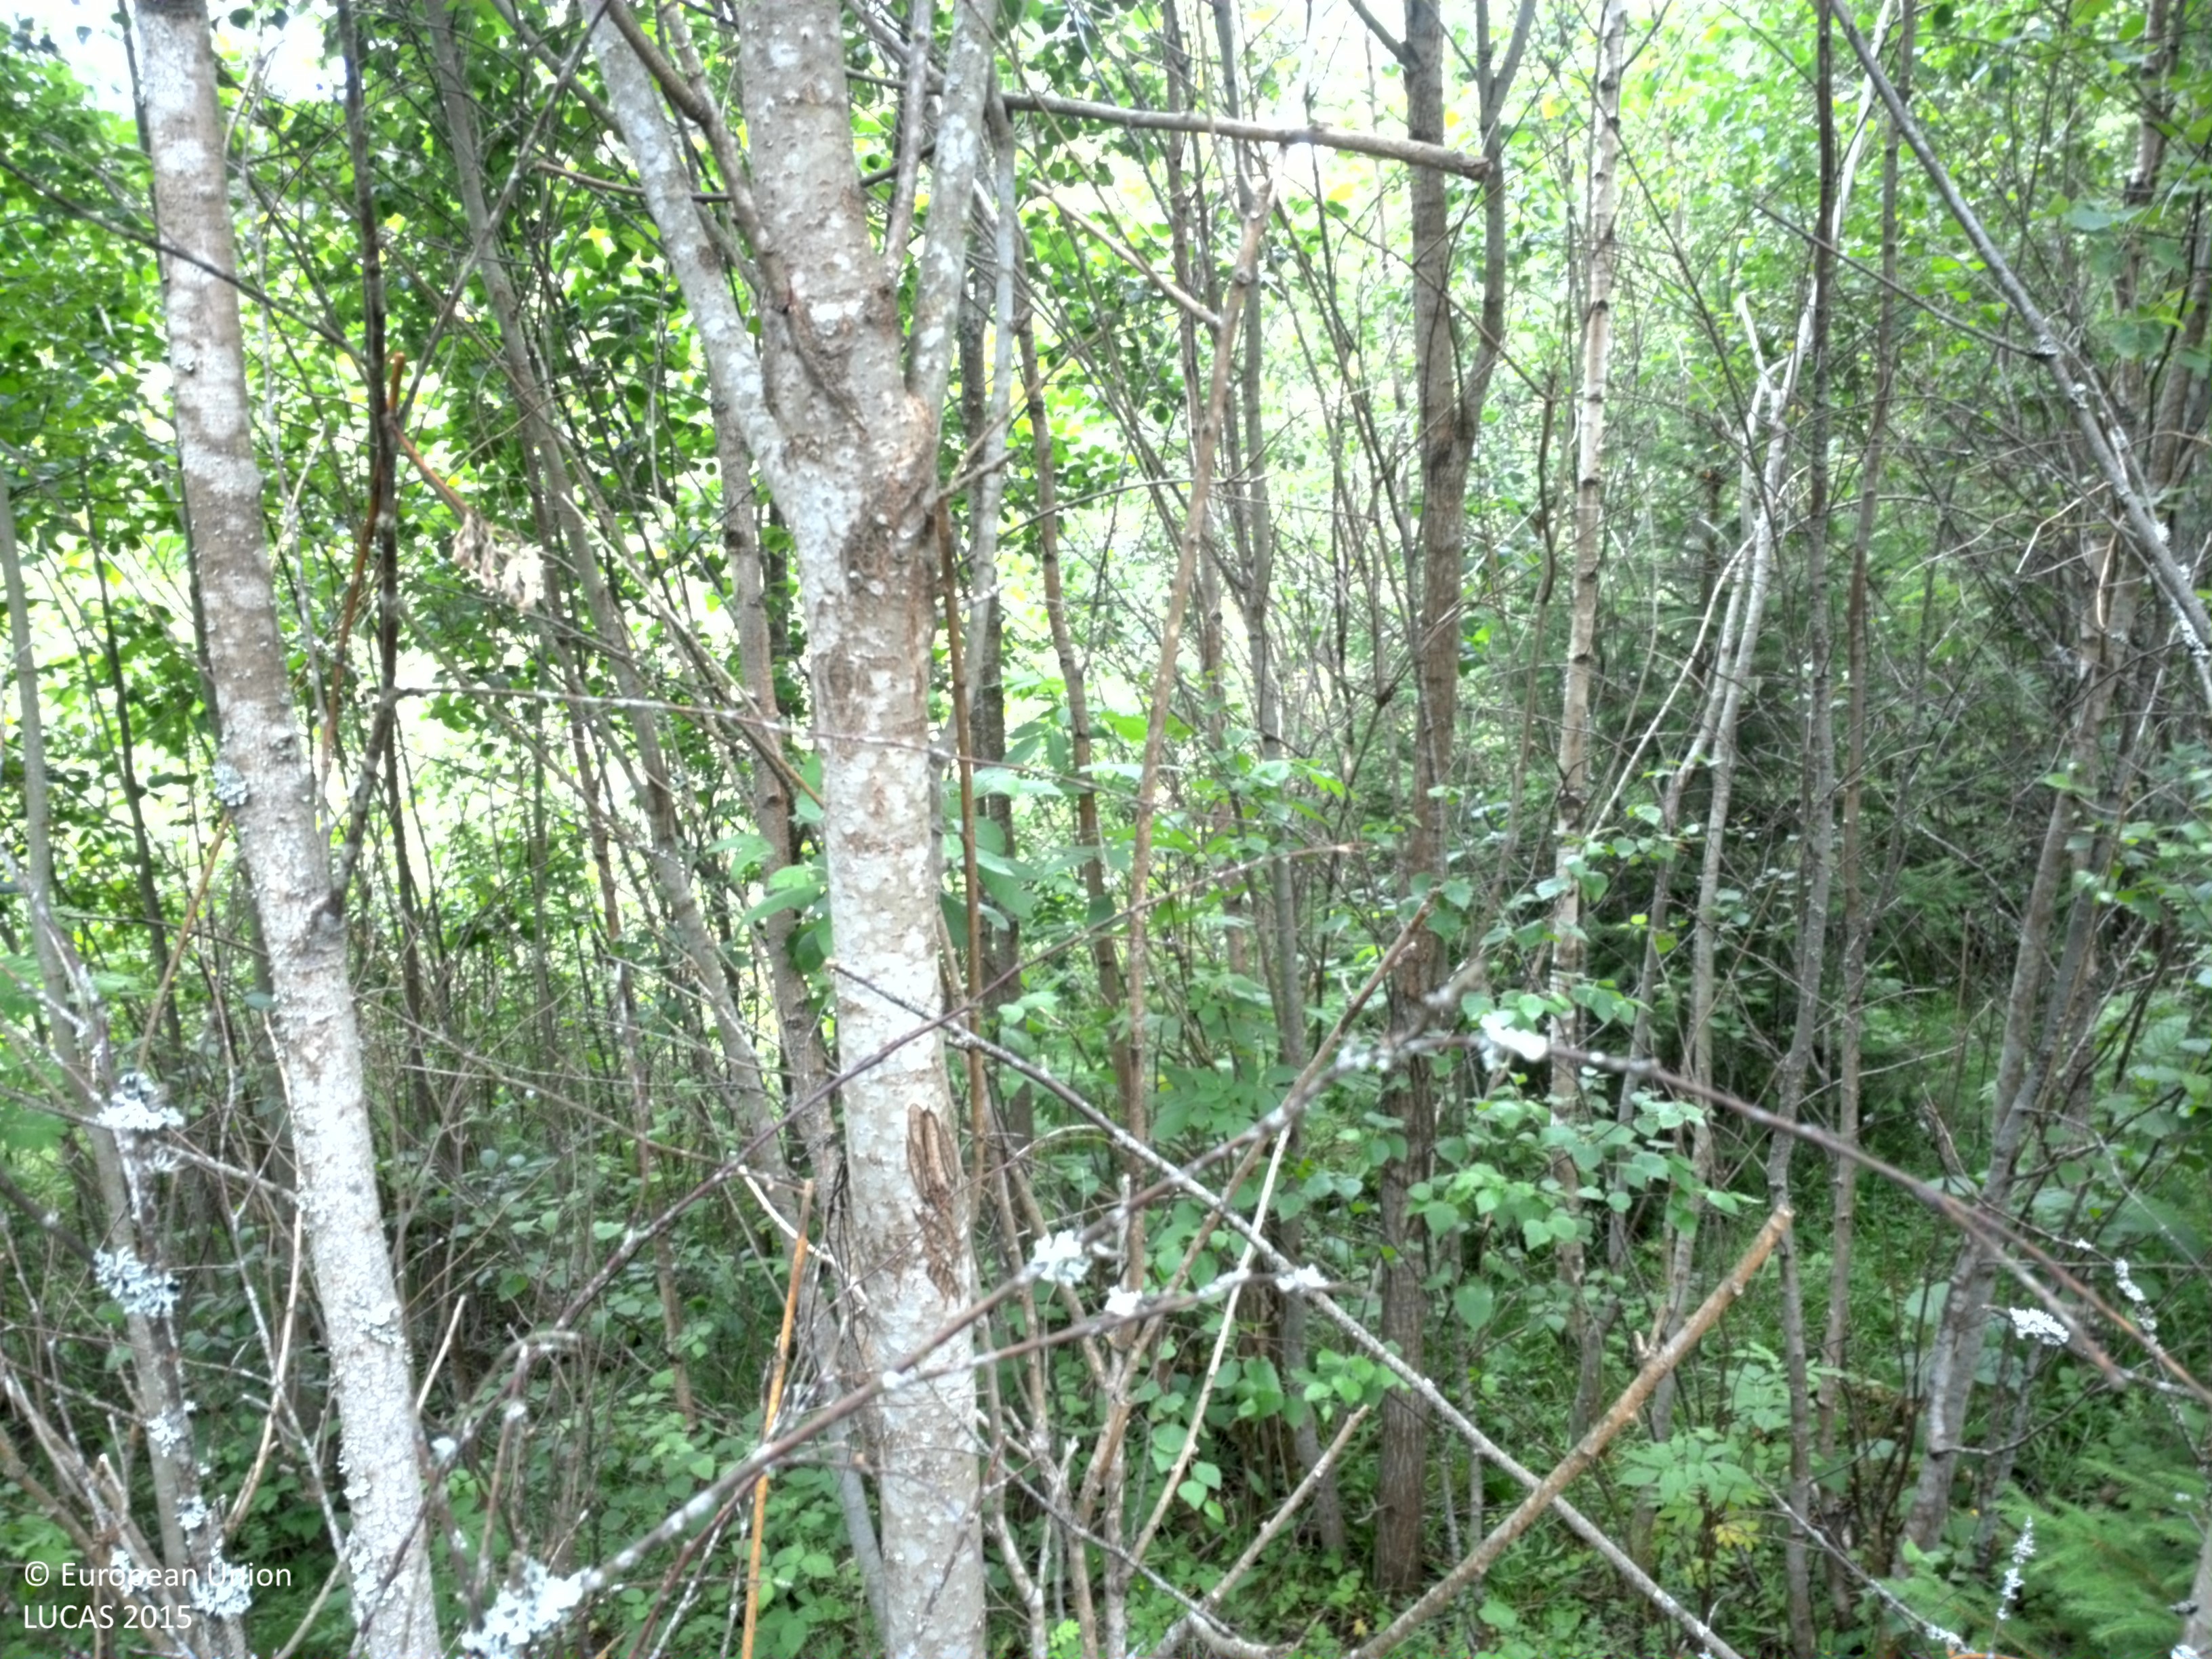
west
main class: Woodland
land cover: Broadleaved woodland
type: hemiboreal forest and nemoral coniferous forest and mixed broadleaved-coniferous forest
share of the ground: > 75 %
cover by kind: broadleaved forest trees 80 %, herbaceous plants 20 %
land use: Forestry
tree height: < 5 m
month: July
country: SE
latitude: 57.5228
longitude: 14.7546
